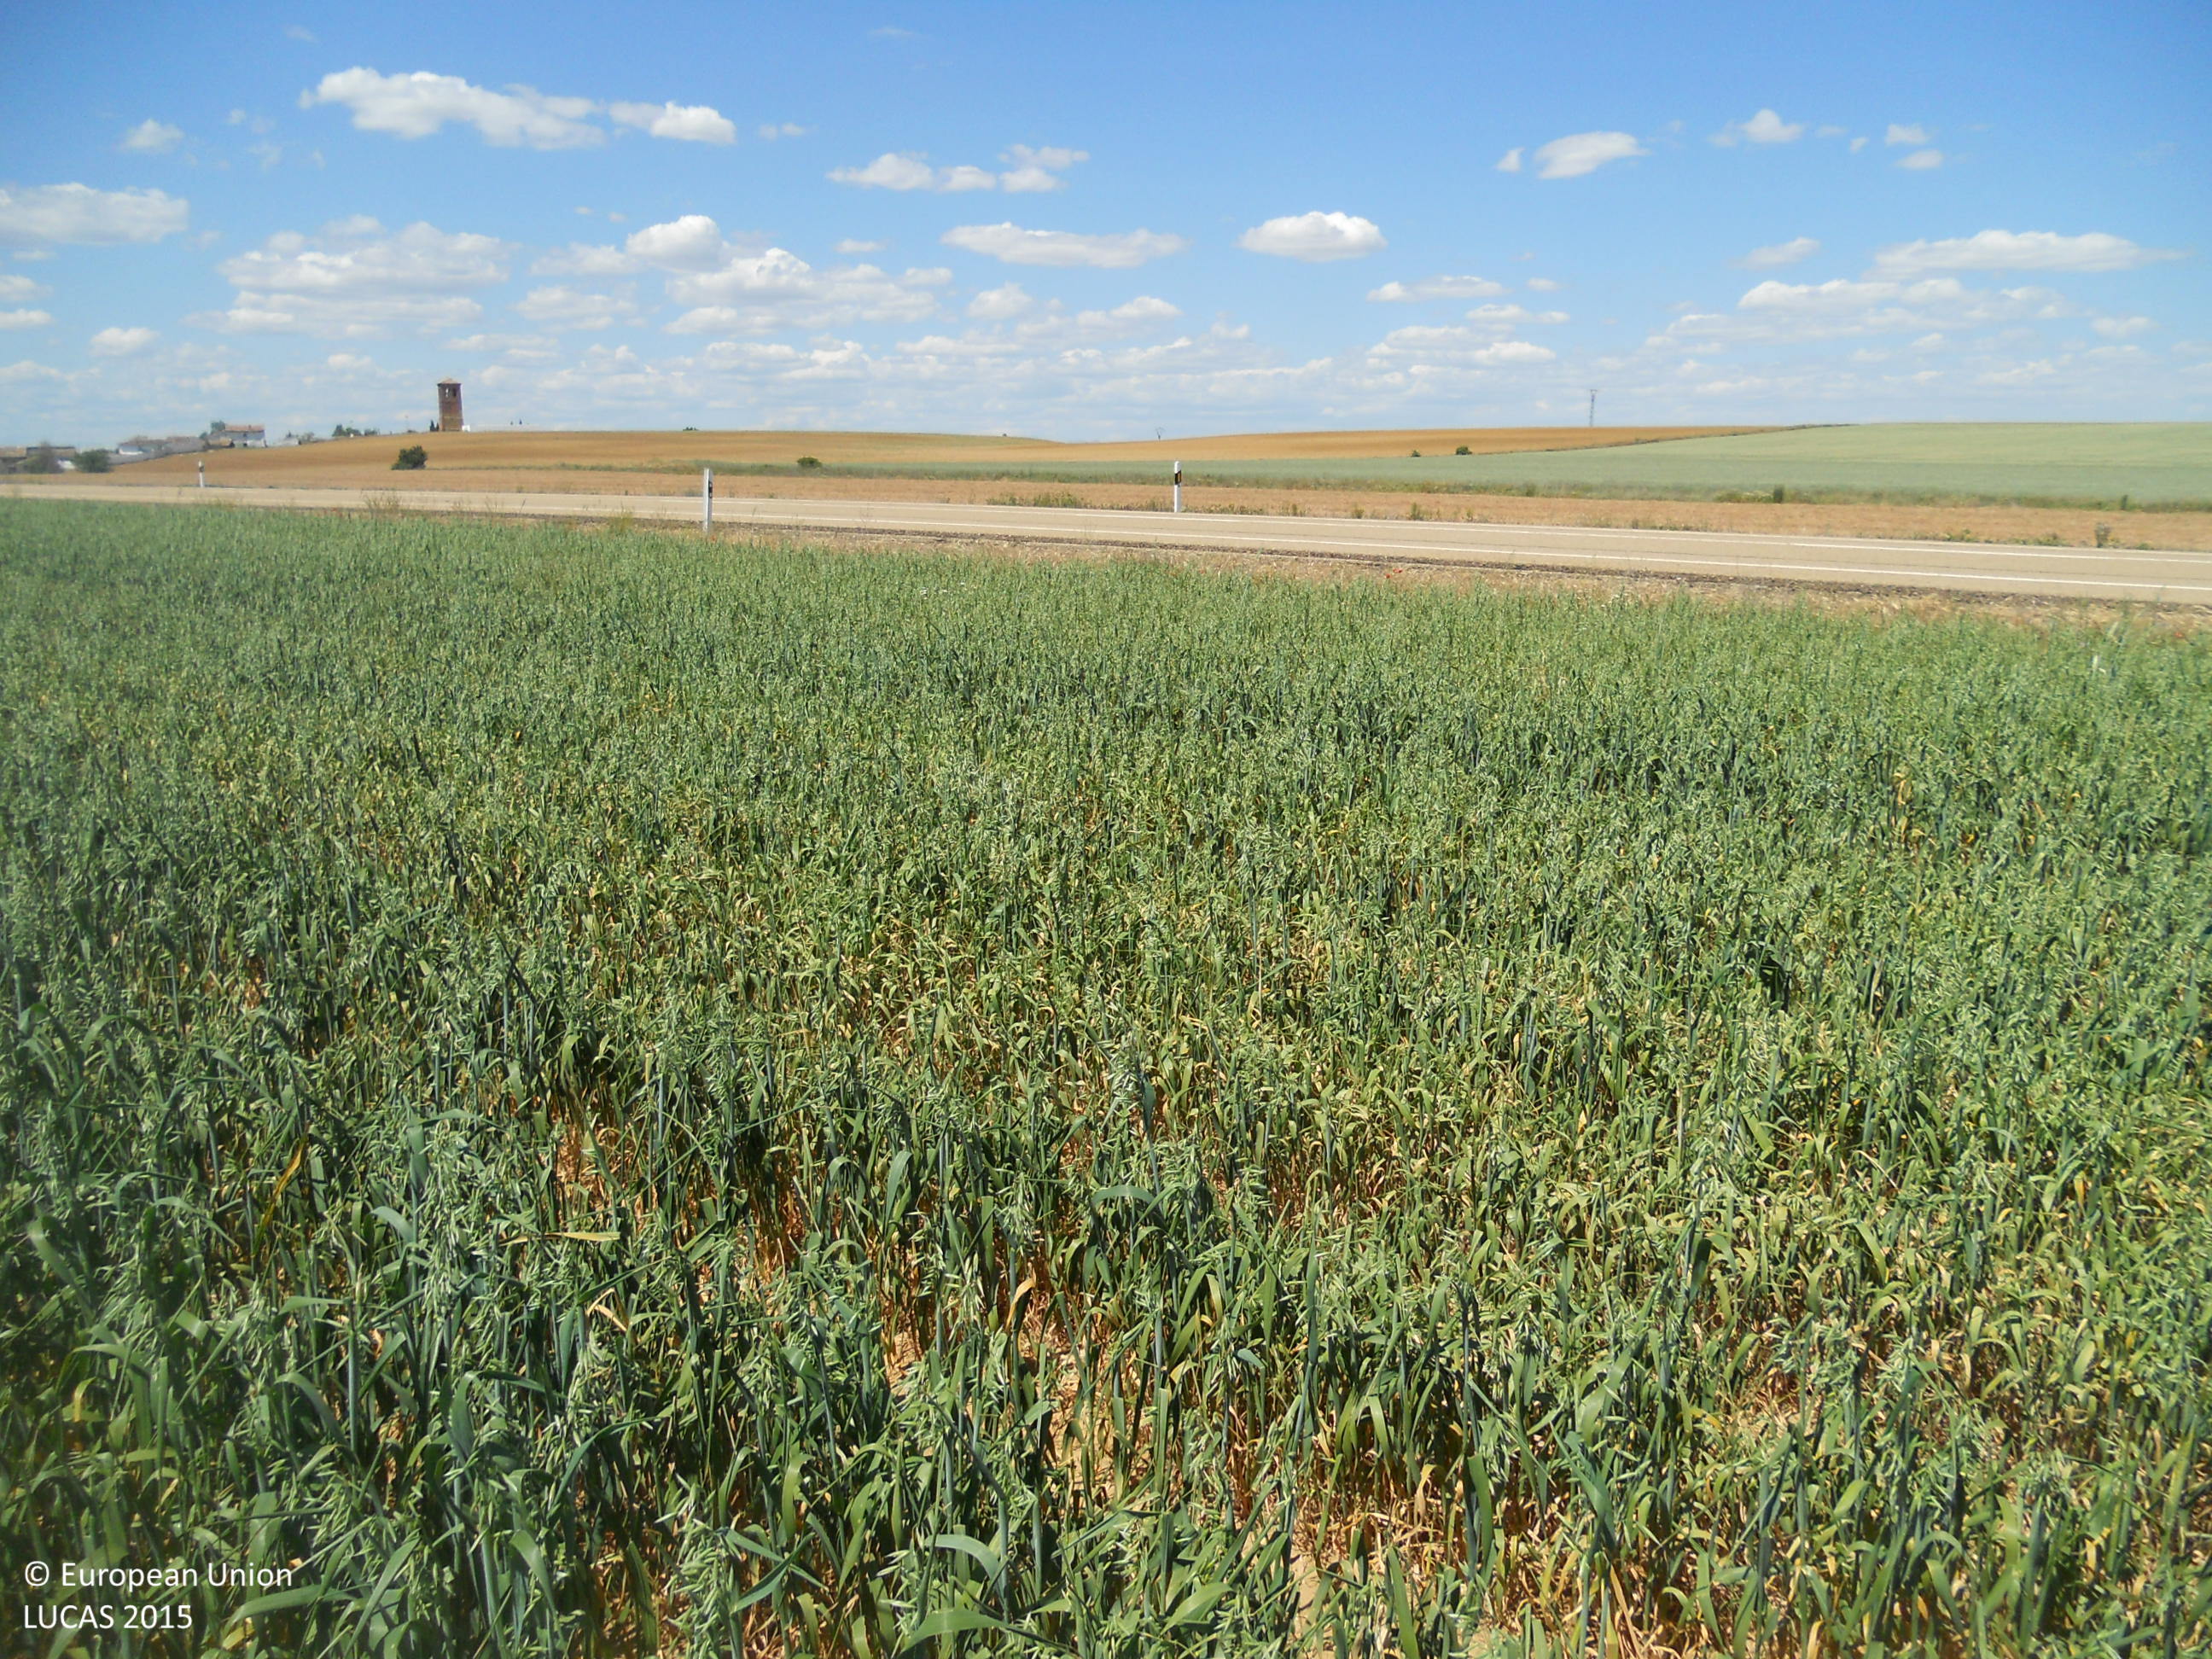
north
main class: Cropland
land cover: Oats
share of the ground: > 75 %
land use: Agriculture (excluding fallow land and kitchen gardens)
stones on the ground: < 10 %
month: May
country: ES
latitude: 42.2944
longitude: -4.7905
